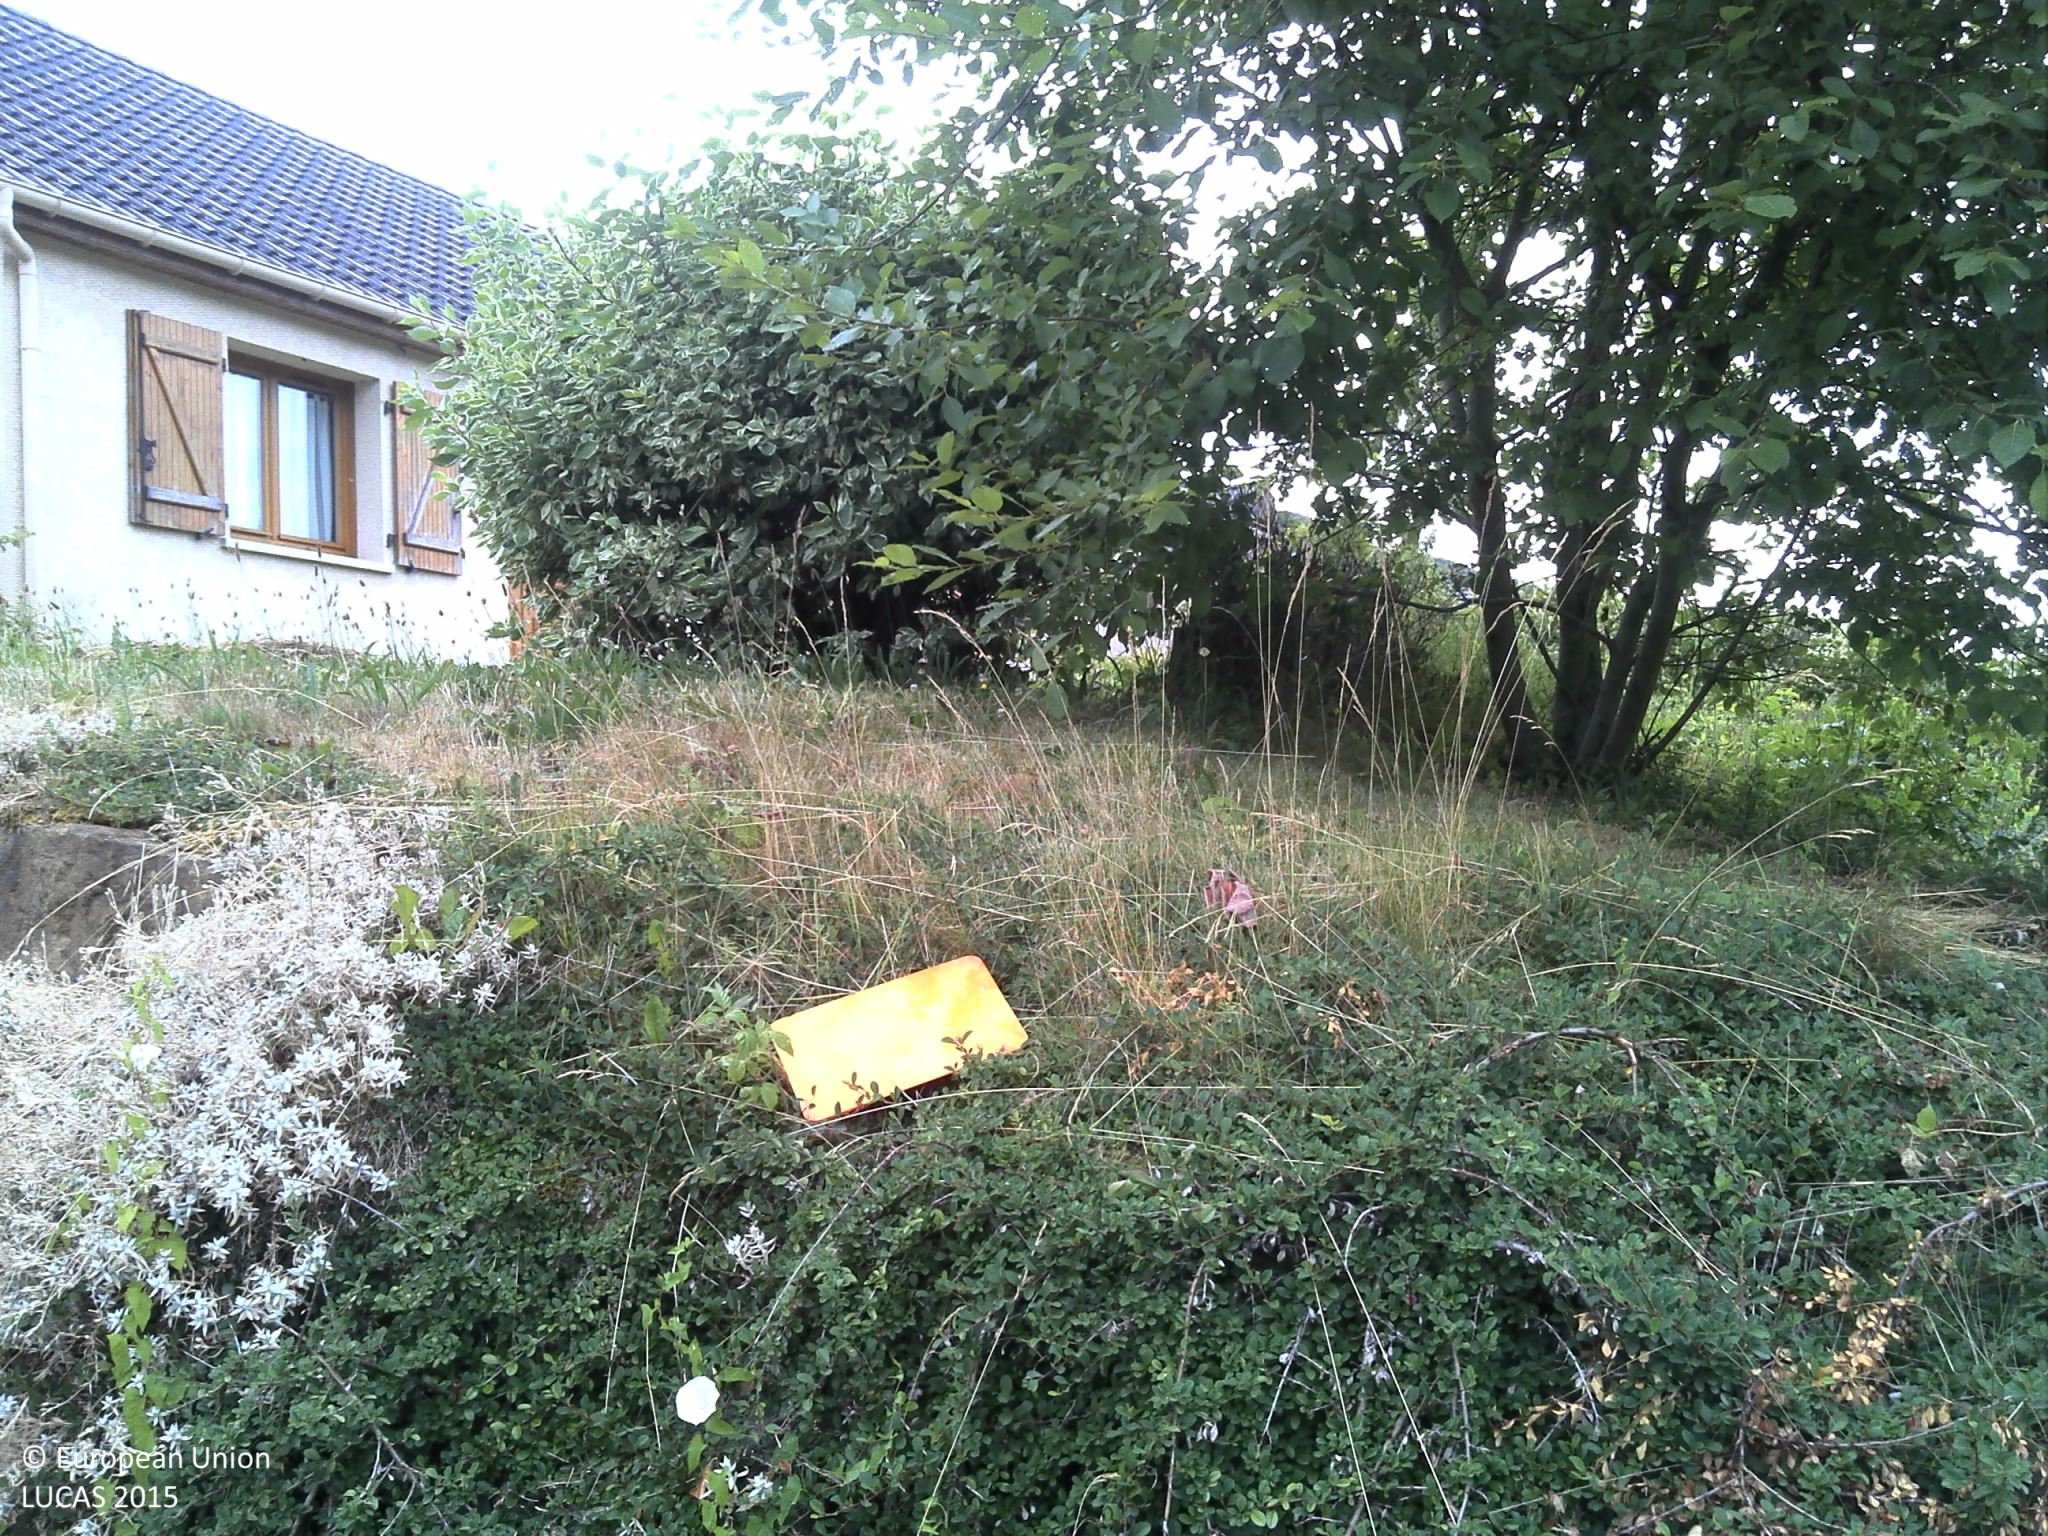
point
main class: Grassland
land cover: Grassland with sparse tree/shrub cover
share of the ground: > 75 %
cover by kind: herbaceous plants 95 %, broadleaved forest trees 5 %
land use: Residential
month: July
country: FR
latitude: 49.8127
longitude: 4.7855
